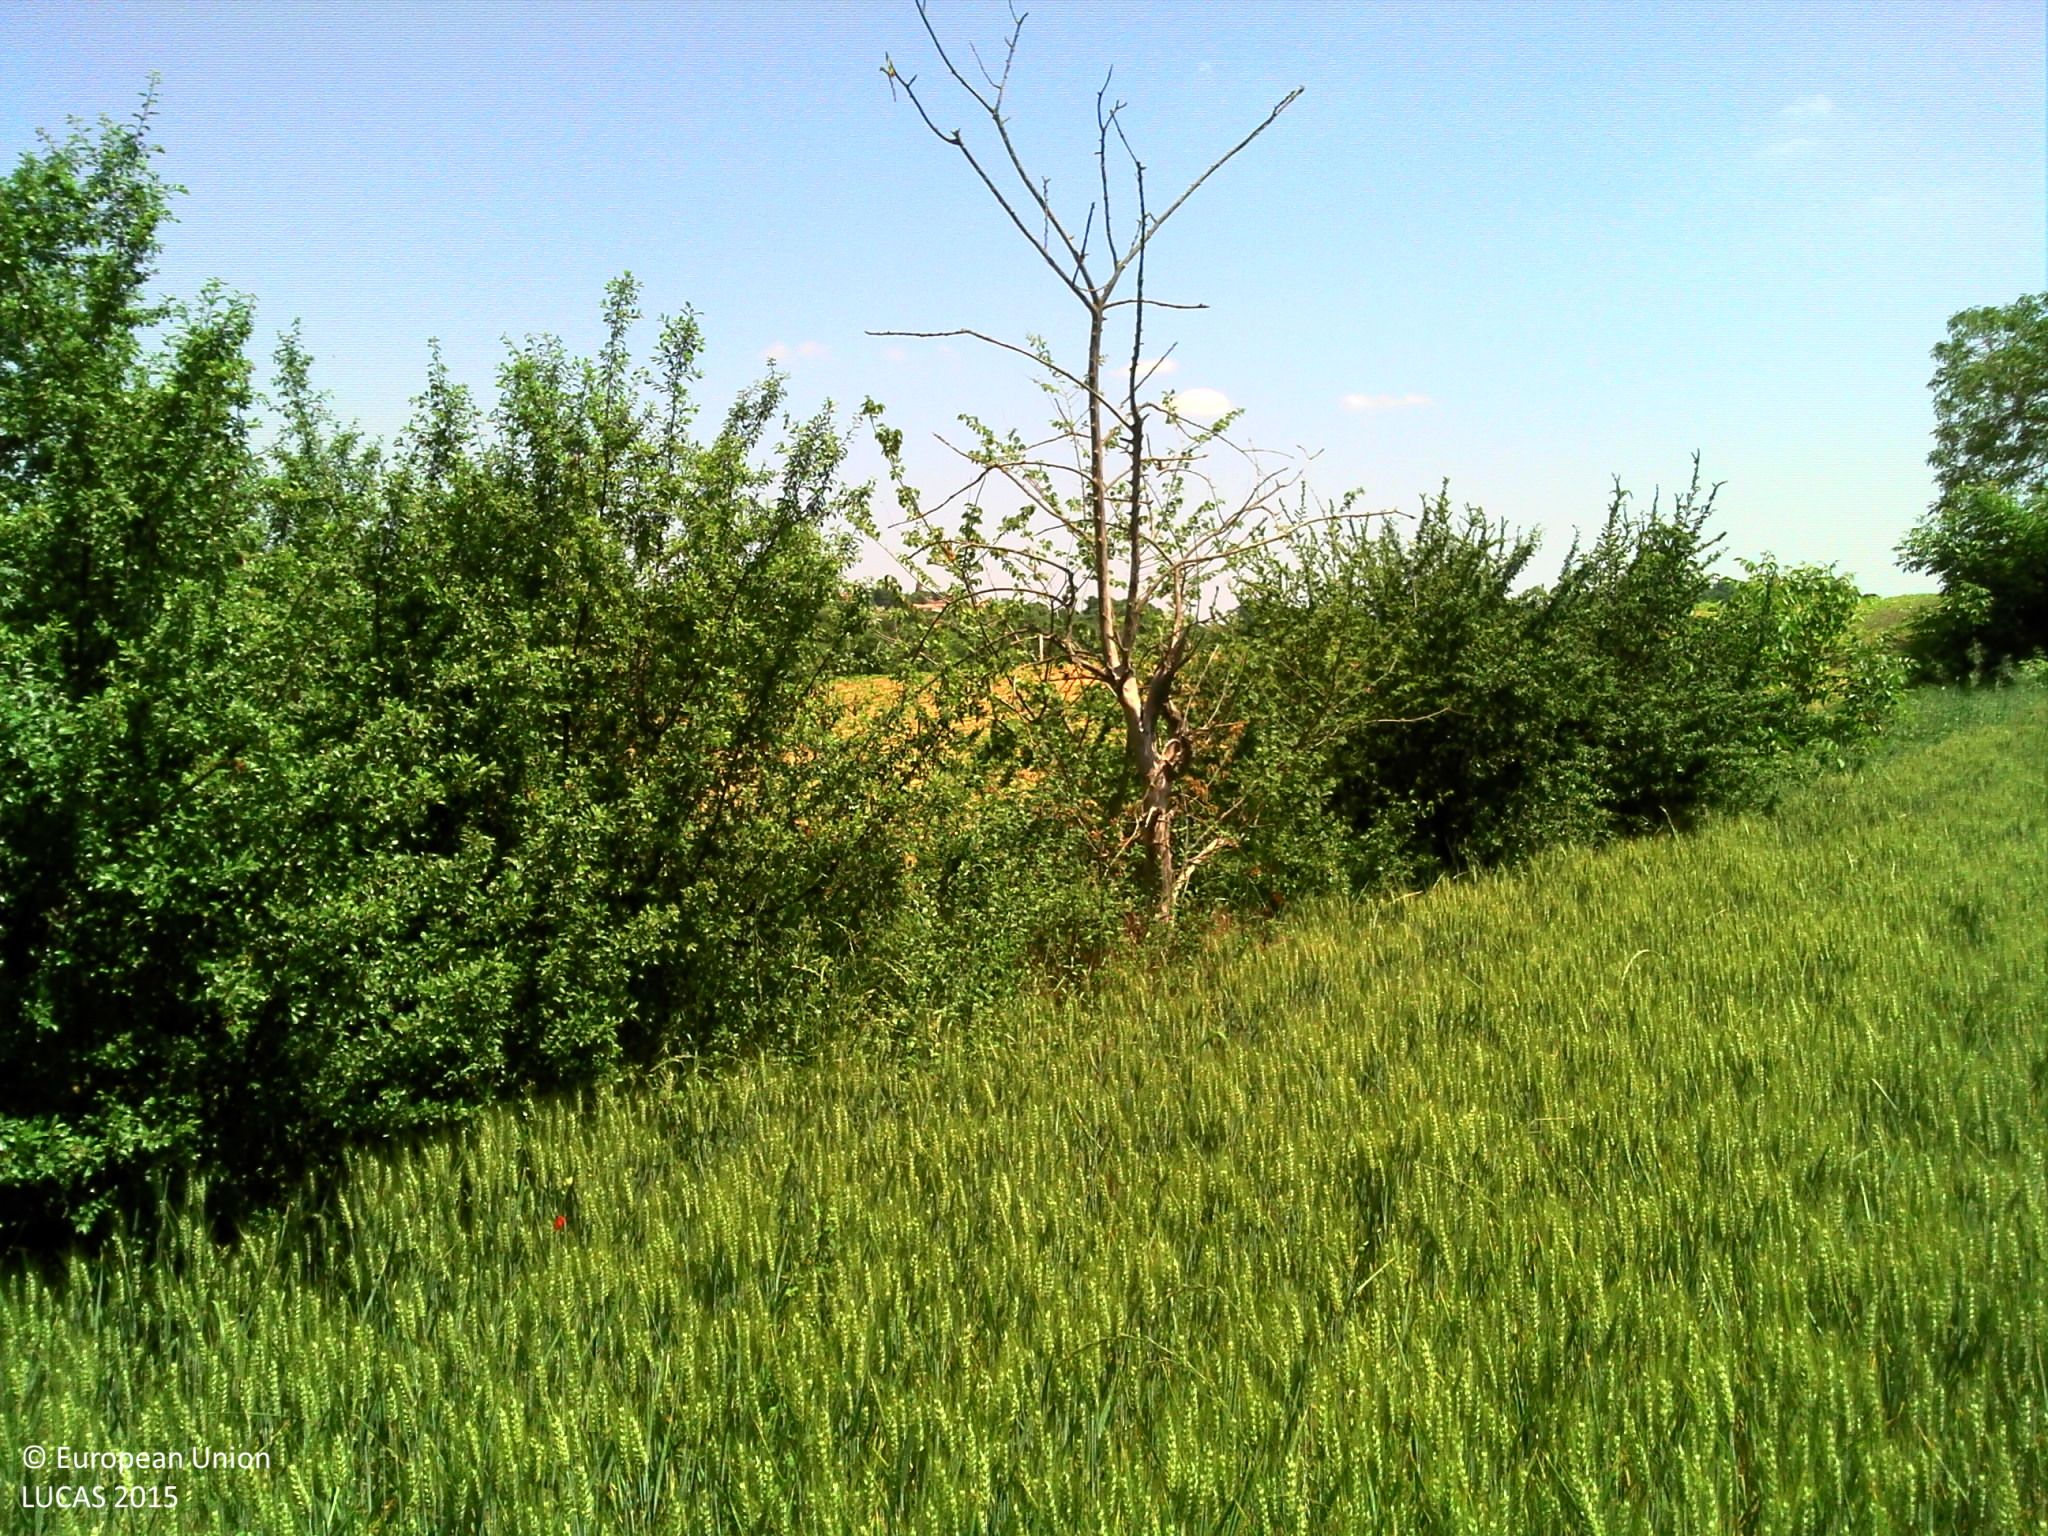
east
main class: Cropland
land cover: Common wheat
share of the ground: > 75 %
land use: Agriculture (excluding fallow land and kitchen gardens)
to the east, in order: Common wheat; Shrubland with sparse tree cover; Grass margins; Sunflower
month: June
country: FR
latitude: 43.5937
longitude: 0.7711
